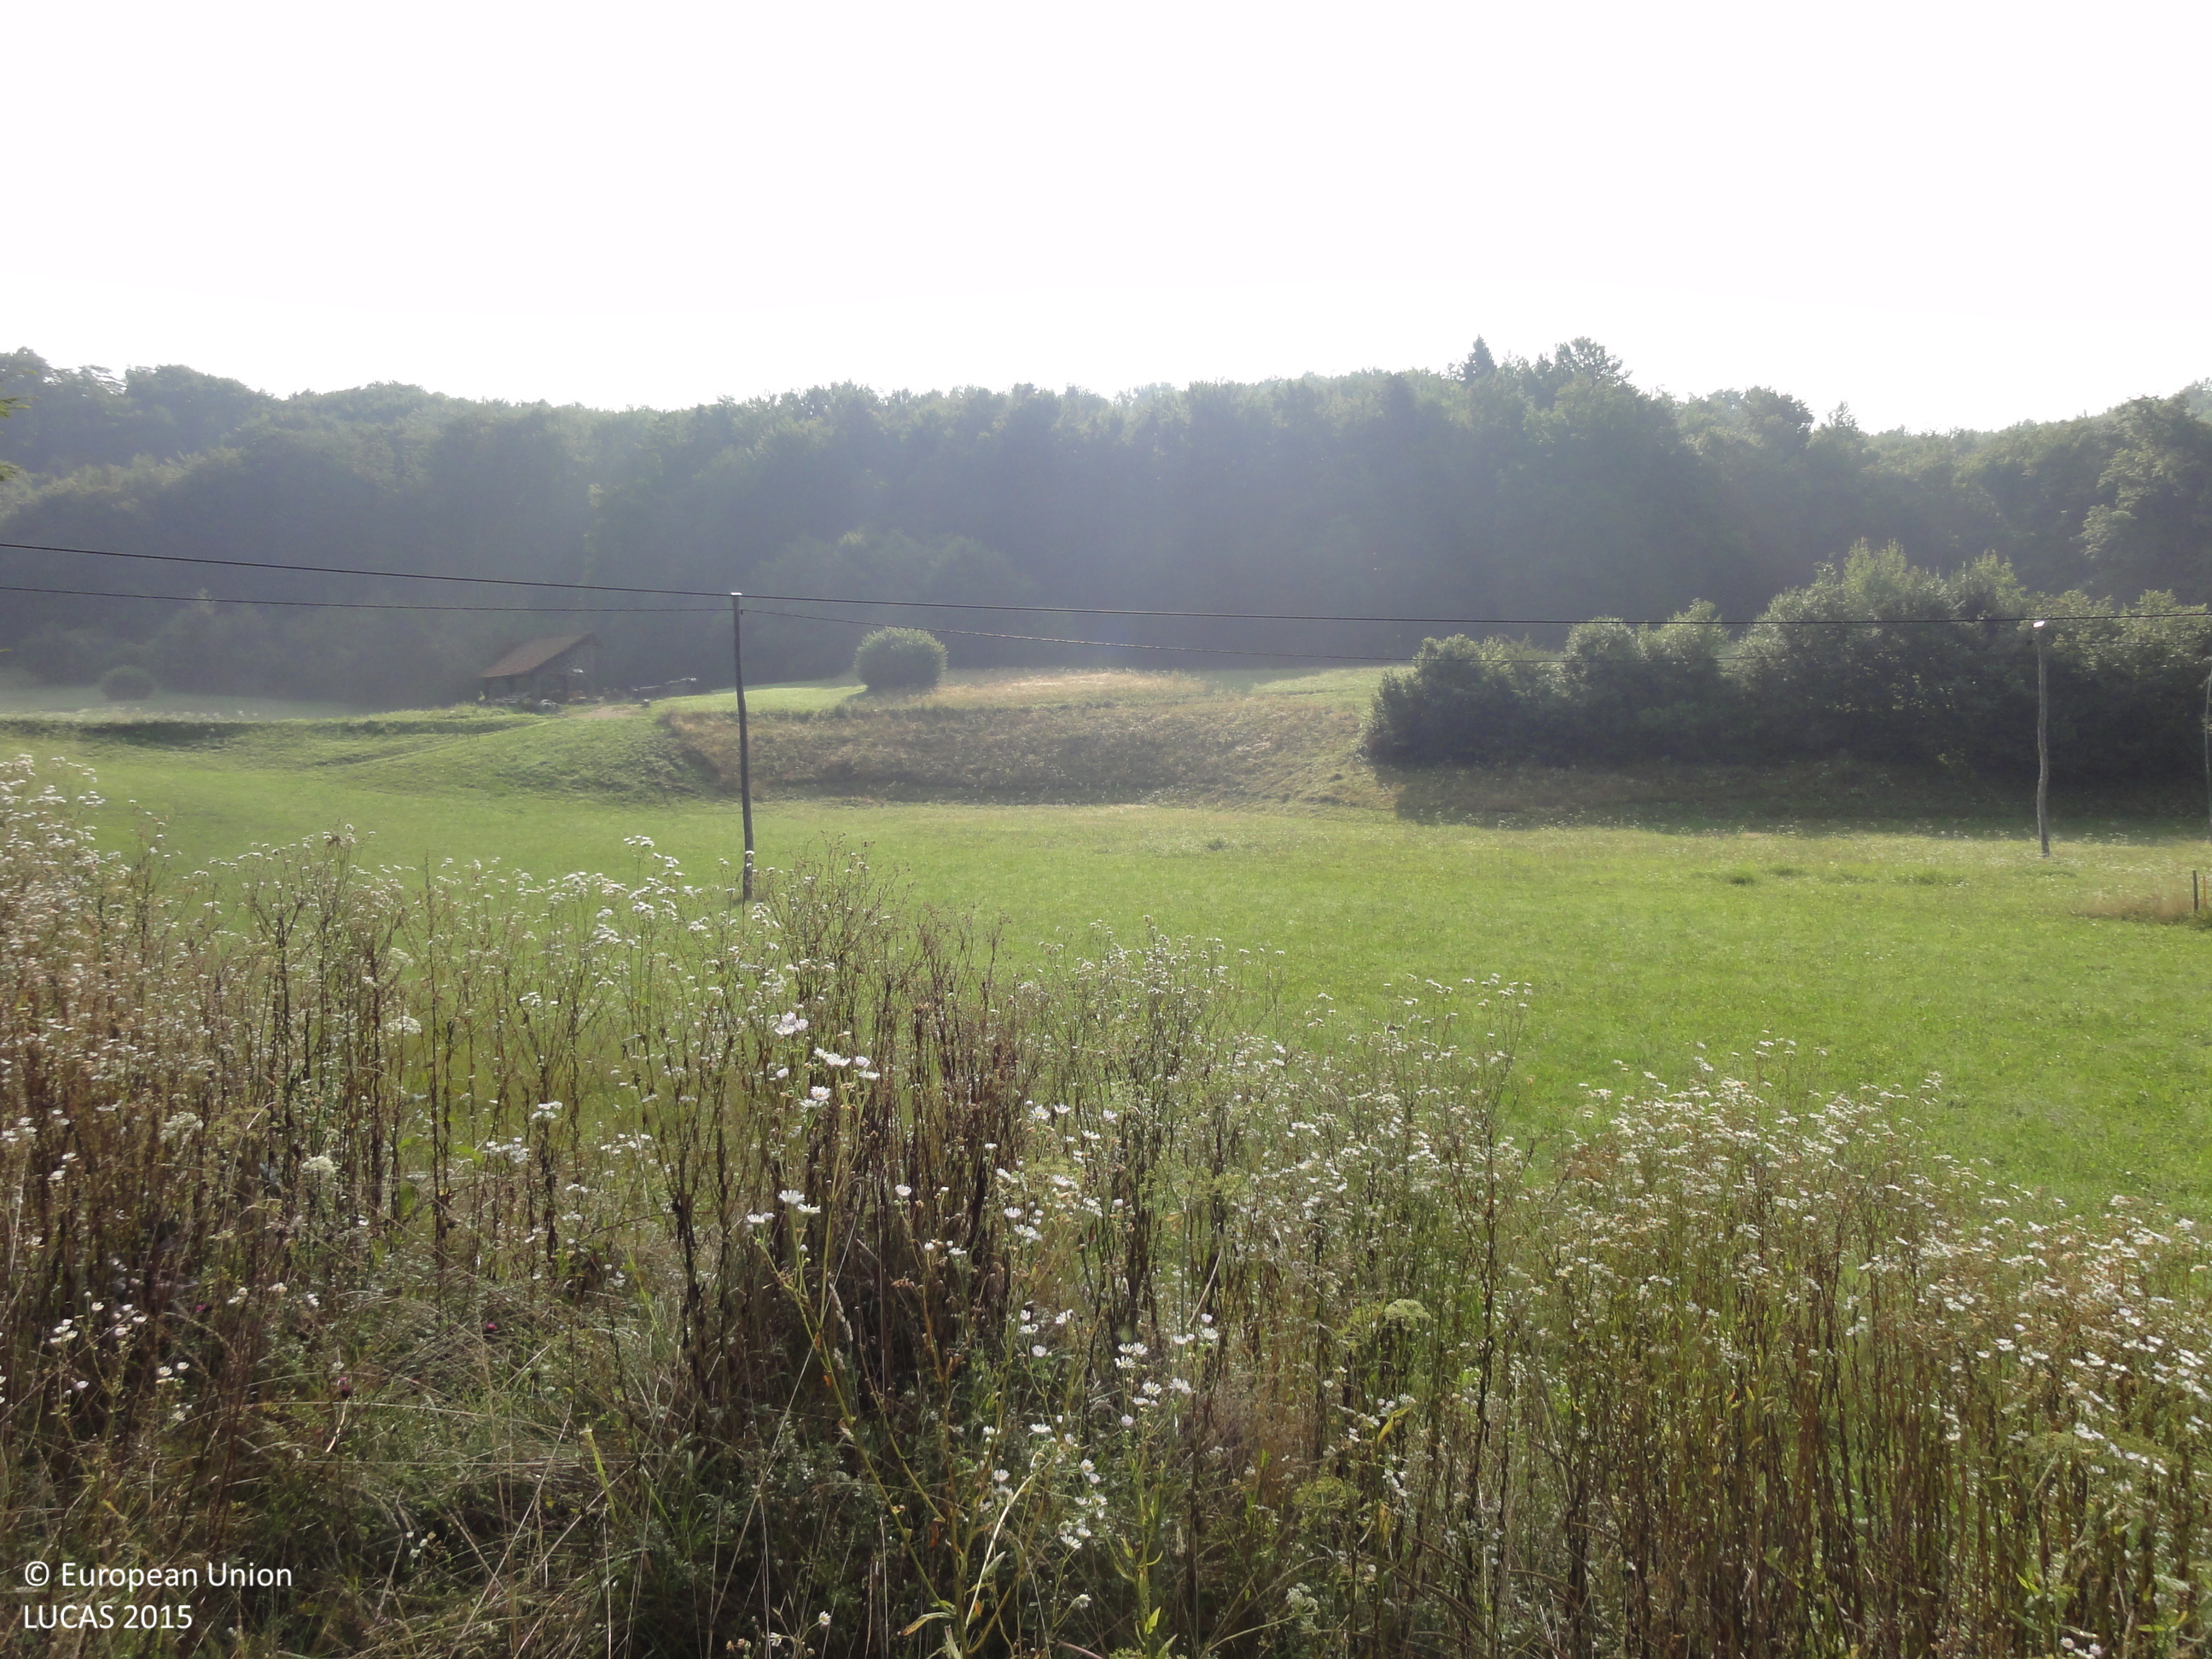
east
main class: Grassland
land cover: Grassland without tree/shrub cover
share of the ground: > 75 %
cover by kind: herbaceous plants 100 %
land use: Agriculture (excluding fallow land and kitchen gardens)
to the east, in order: Grassland without tree/shrub cover; Electric lines; Grassland without tree/shrub cover; Paved roads, cycling and walking lanes; Grassland without tree/shrub cover; Tracks; Broadleaved woodland; Tracks; Broadleaved woodland
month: August
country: SI
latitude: 45.8811
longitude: 15.2151
